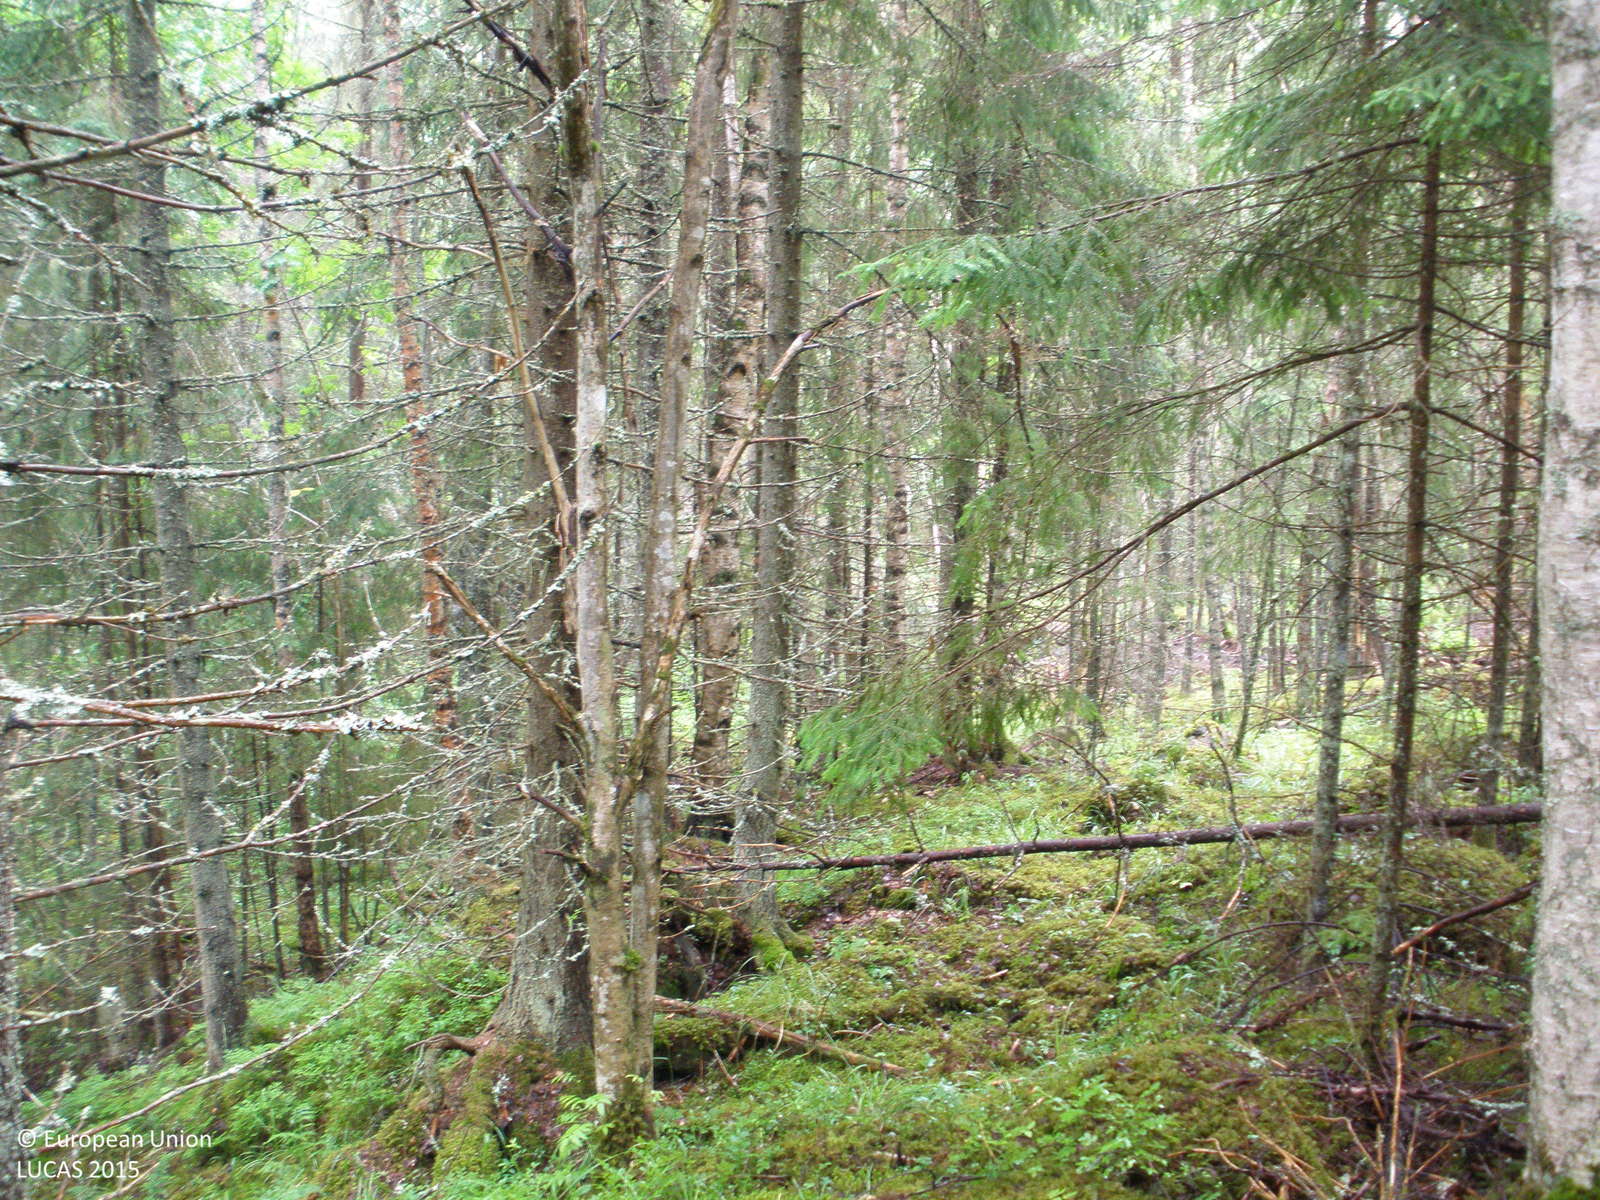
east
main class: Woodland
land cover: Spruce dominated mixed woodland
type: boreal forest
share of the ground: > 75 %
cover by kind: coniferous forest trees 40 %, broadleaved forest trees 40 %, herbaceous plants 10 %, lichens and mosses 10 %
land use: Forestry
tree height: > 5 m
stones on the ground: 10 - 25 %
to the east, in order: Spruce dominated mixed woodland; Other mixed woodland; Rivers and streams; Spruce dominated mixed woodland; Tracks; Spruce dominated mixed woodland; Ditches and canals; Grass margins; Tracks; Grass margins; Ditches and canals; Spruce dominated coniferous woodland
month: July
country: FI
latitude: 61.4509
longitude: 23.3001
